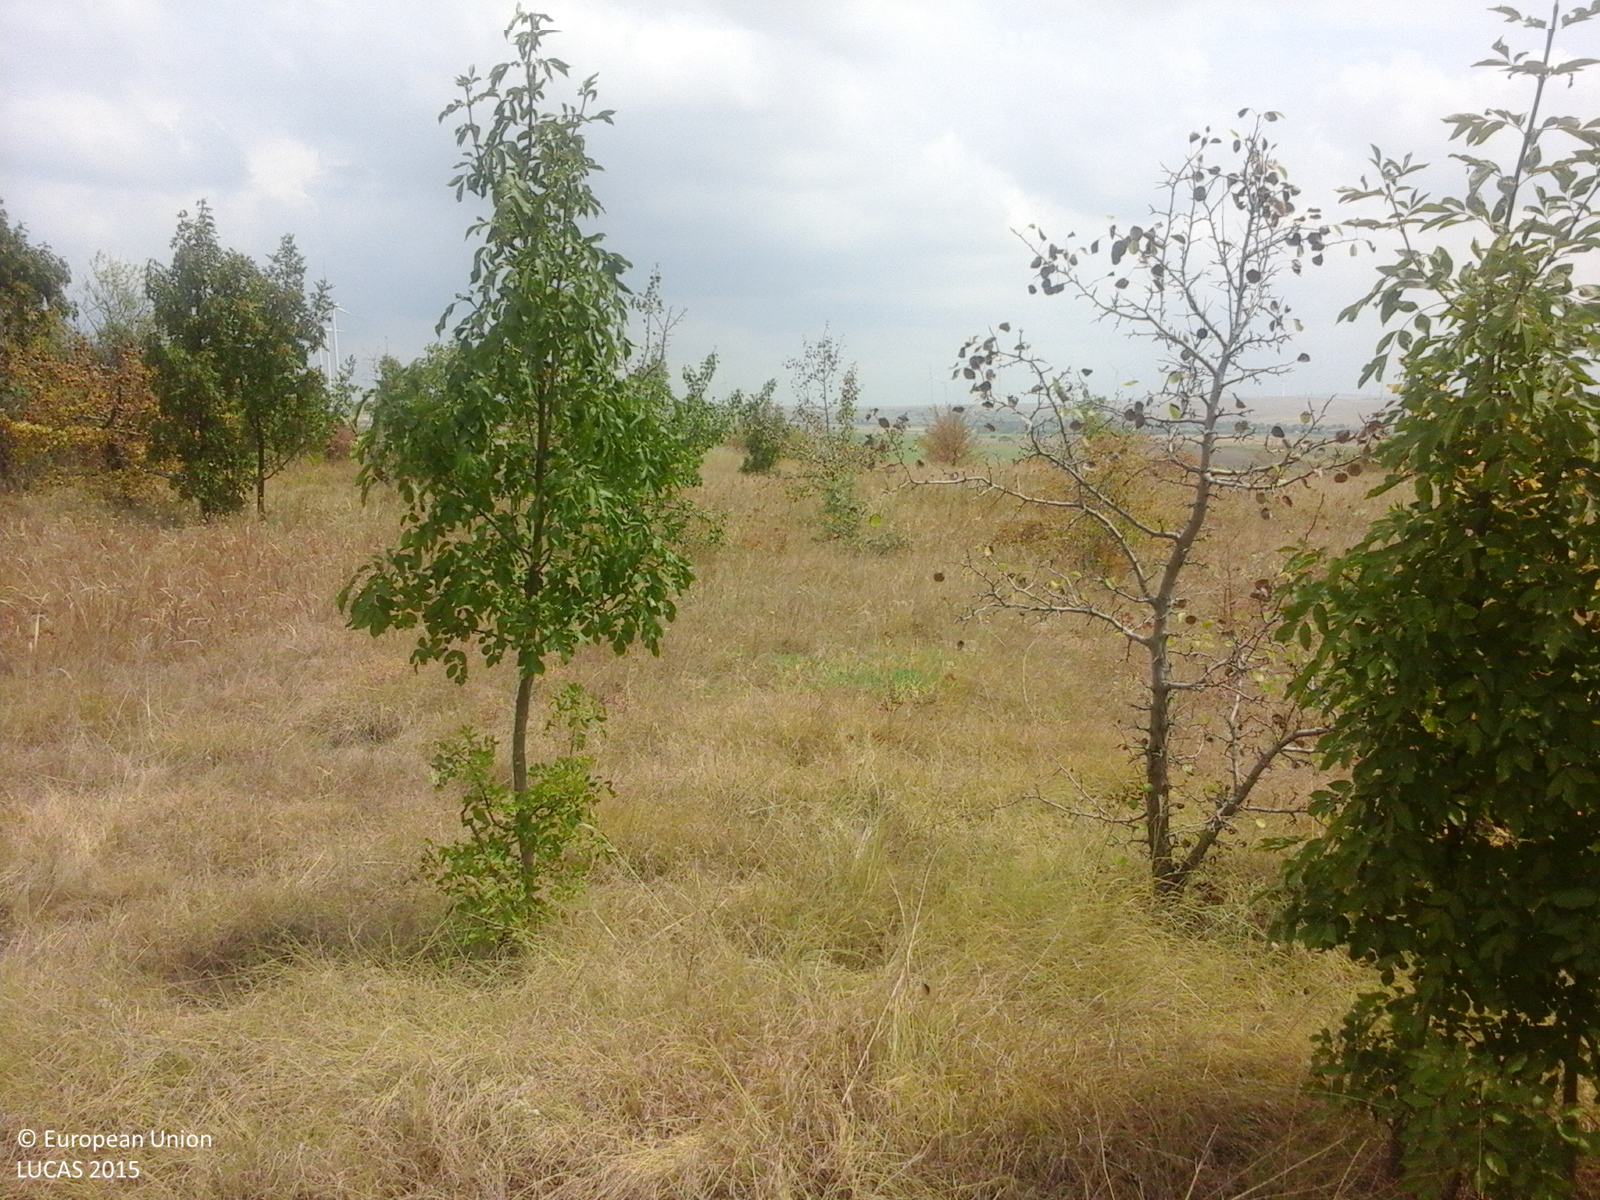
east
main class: Grassland
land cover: Grassland with sparse tree/shrub cover
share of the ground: > 75 %
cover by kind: herbaceous plants 95 %, broadleaved forest trees 5 %
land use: Fallow land
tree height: < 5 m
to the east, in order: Grassland with sparse tree/shrub cover; Tracks; Grassland with sparse tree/shrub cover; Sunflower; Electric lines; Sunflower
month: July
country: RO
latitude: 44.9033
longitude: 28.2948
